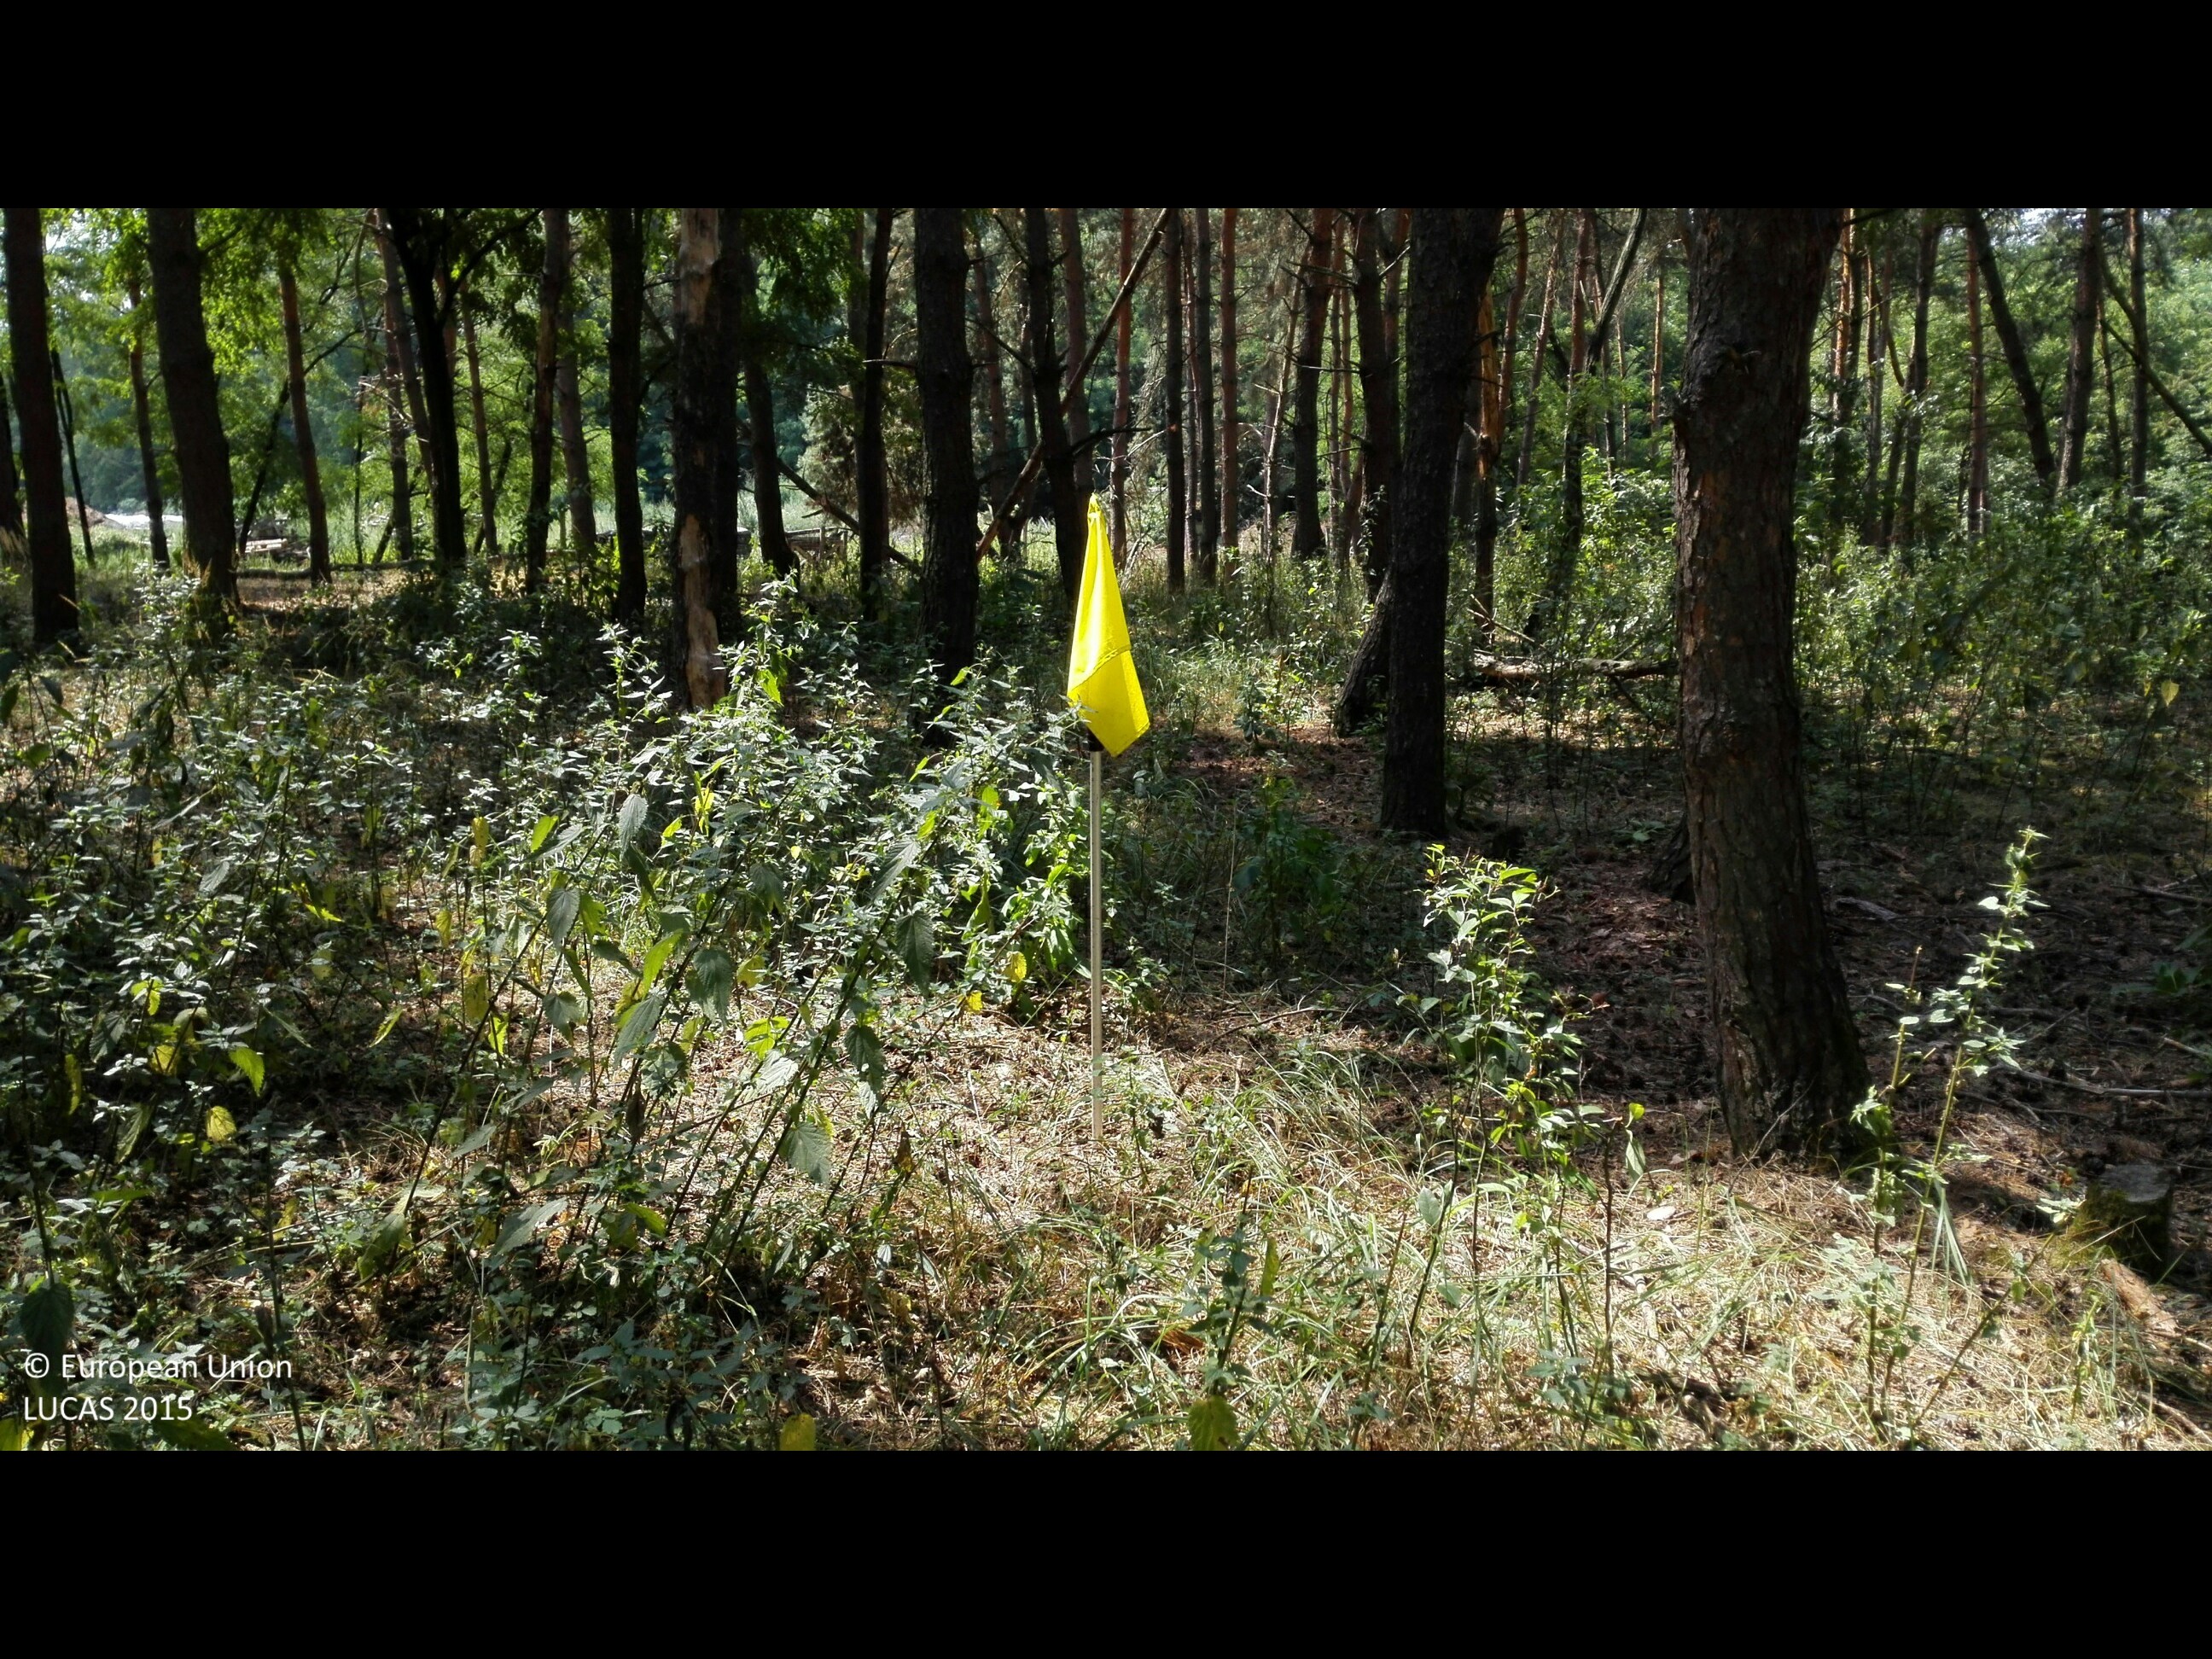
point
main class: Woodland
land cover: Pine dominated coniferous woodland
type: hemiboreal forest and nemoral coniferous forest and mixed broadleaved-coniferous forest
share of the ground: > 75 %
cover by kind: coniferous forest trees 95 %, broadleaved forest trees 5 %
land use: Forestry
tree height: > 5 m
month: August
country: HU
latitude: 47.6302
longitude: 21.9064
